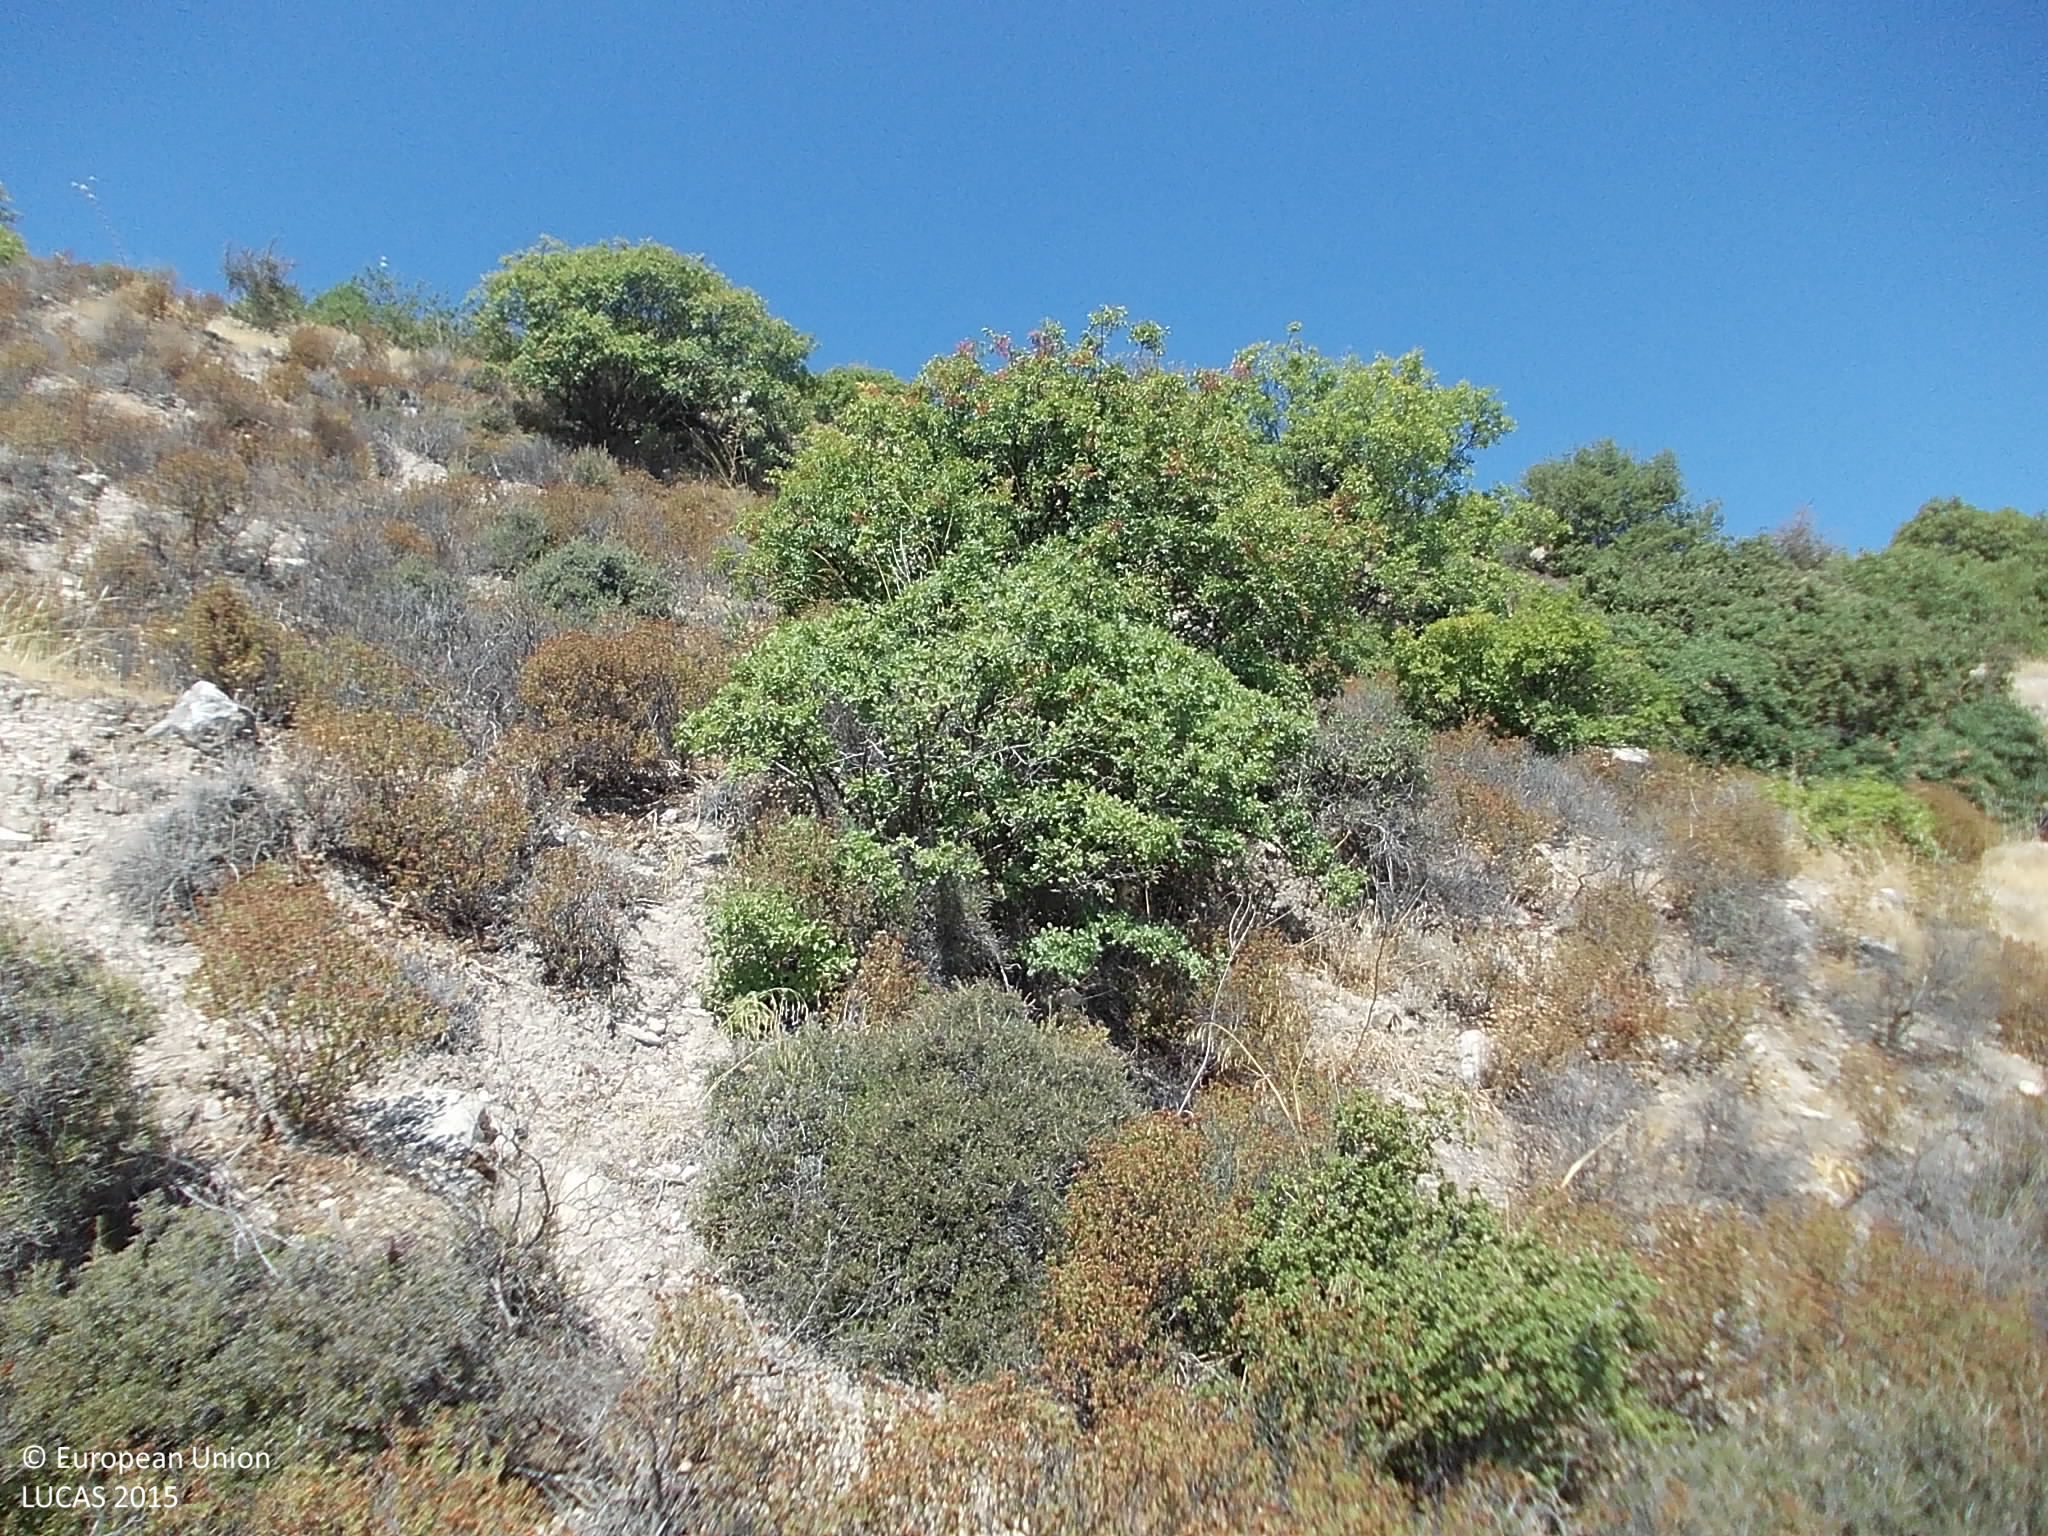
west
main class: Shrubland
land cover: Shrubland with sparse tree cover
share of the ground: > 75 %
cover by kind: shrubs 90 %, coniferous forest trees 5 %, unconsolidated bare surface 5 %
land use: Semi-natural and natural areas not in use
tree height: > 5 m
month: August
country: CY
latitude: 34.7811
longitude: 32.9034
